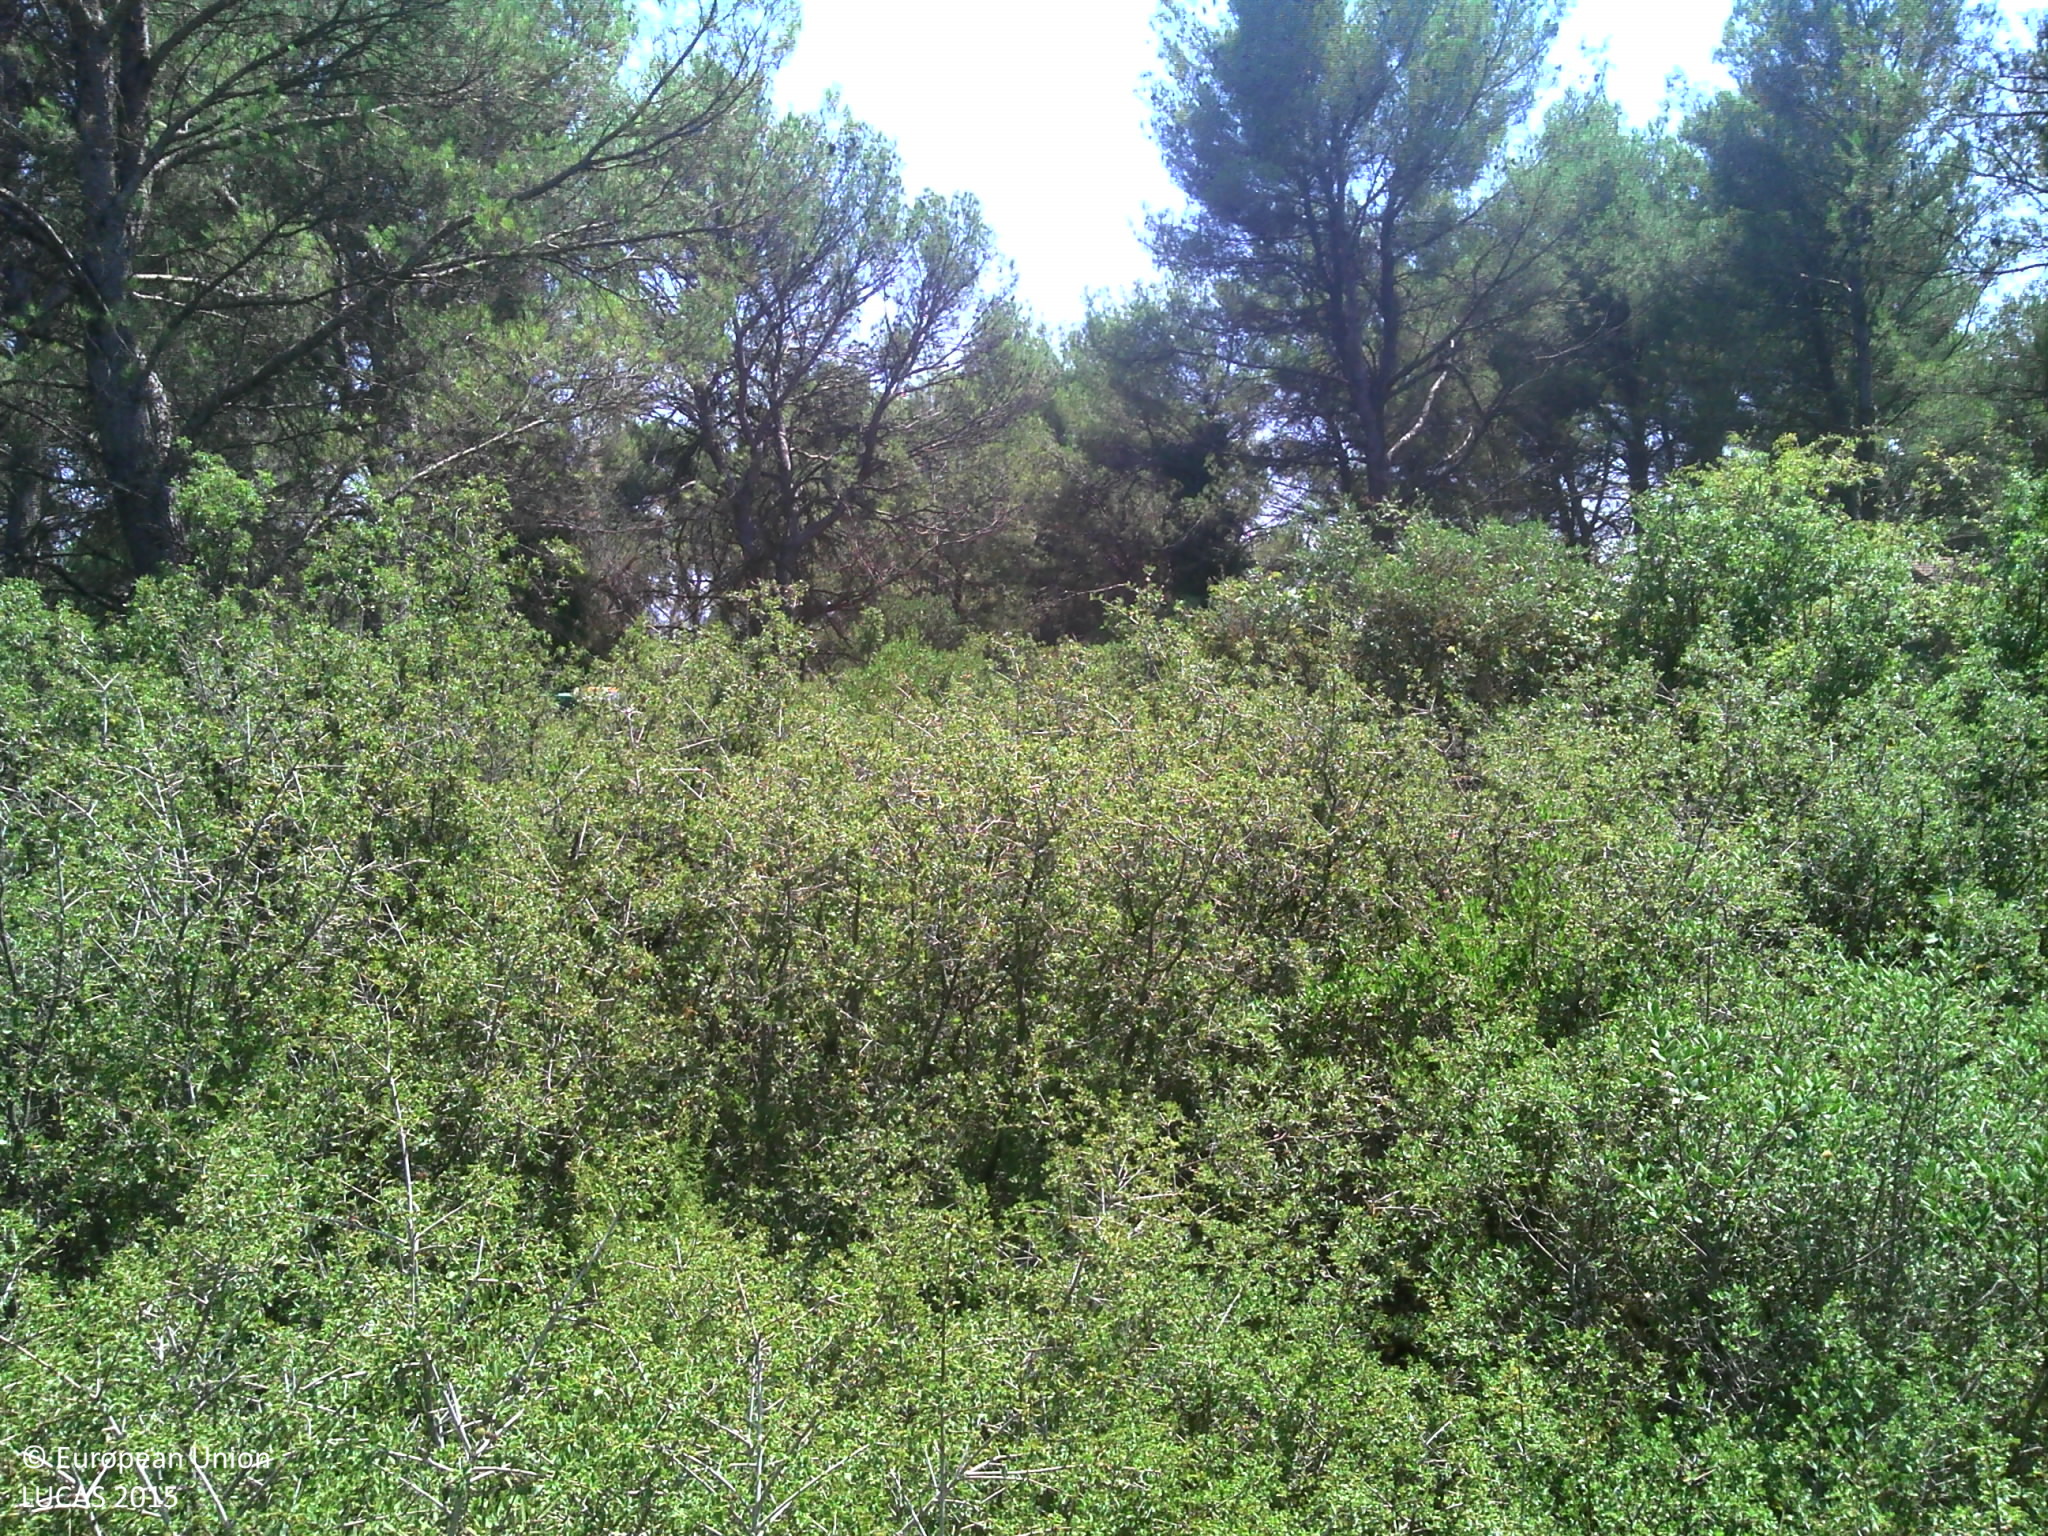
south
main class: Shrubland
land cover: Shrubland without tree cover
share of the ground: > 75 %
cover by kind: shrubs 80 %, herbaceous plants 15 %, unconsolidated bare surface 5 %
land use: Semi-natural and natural areas not in use
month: August
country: FR
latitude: 43.5234
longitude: 5.3454
